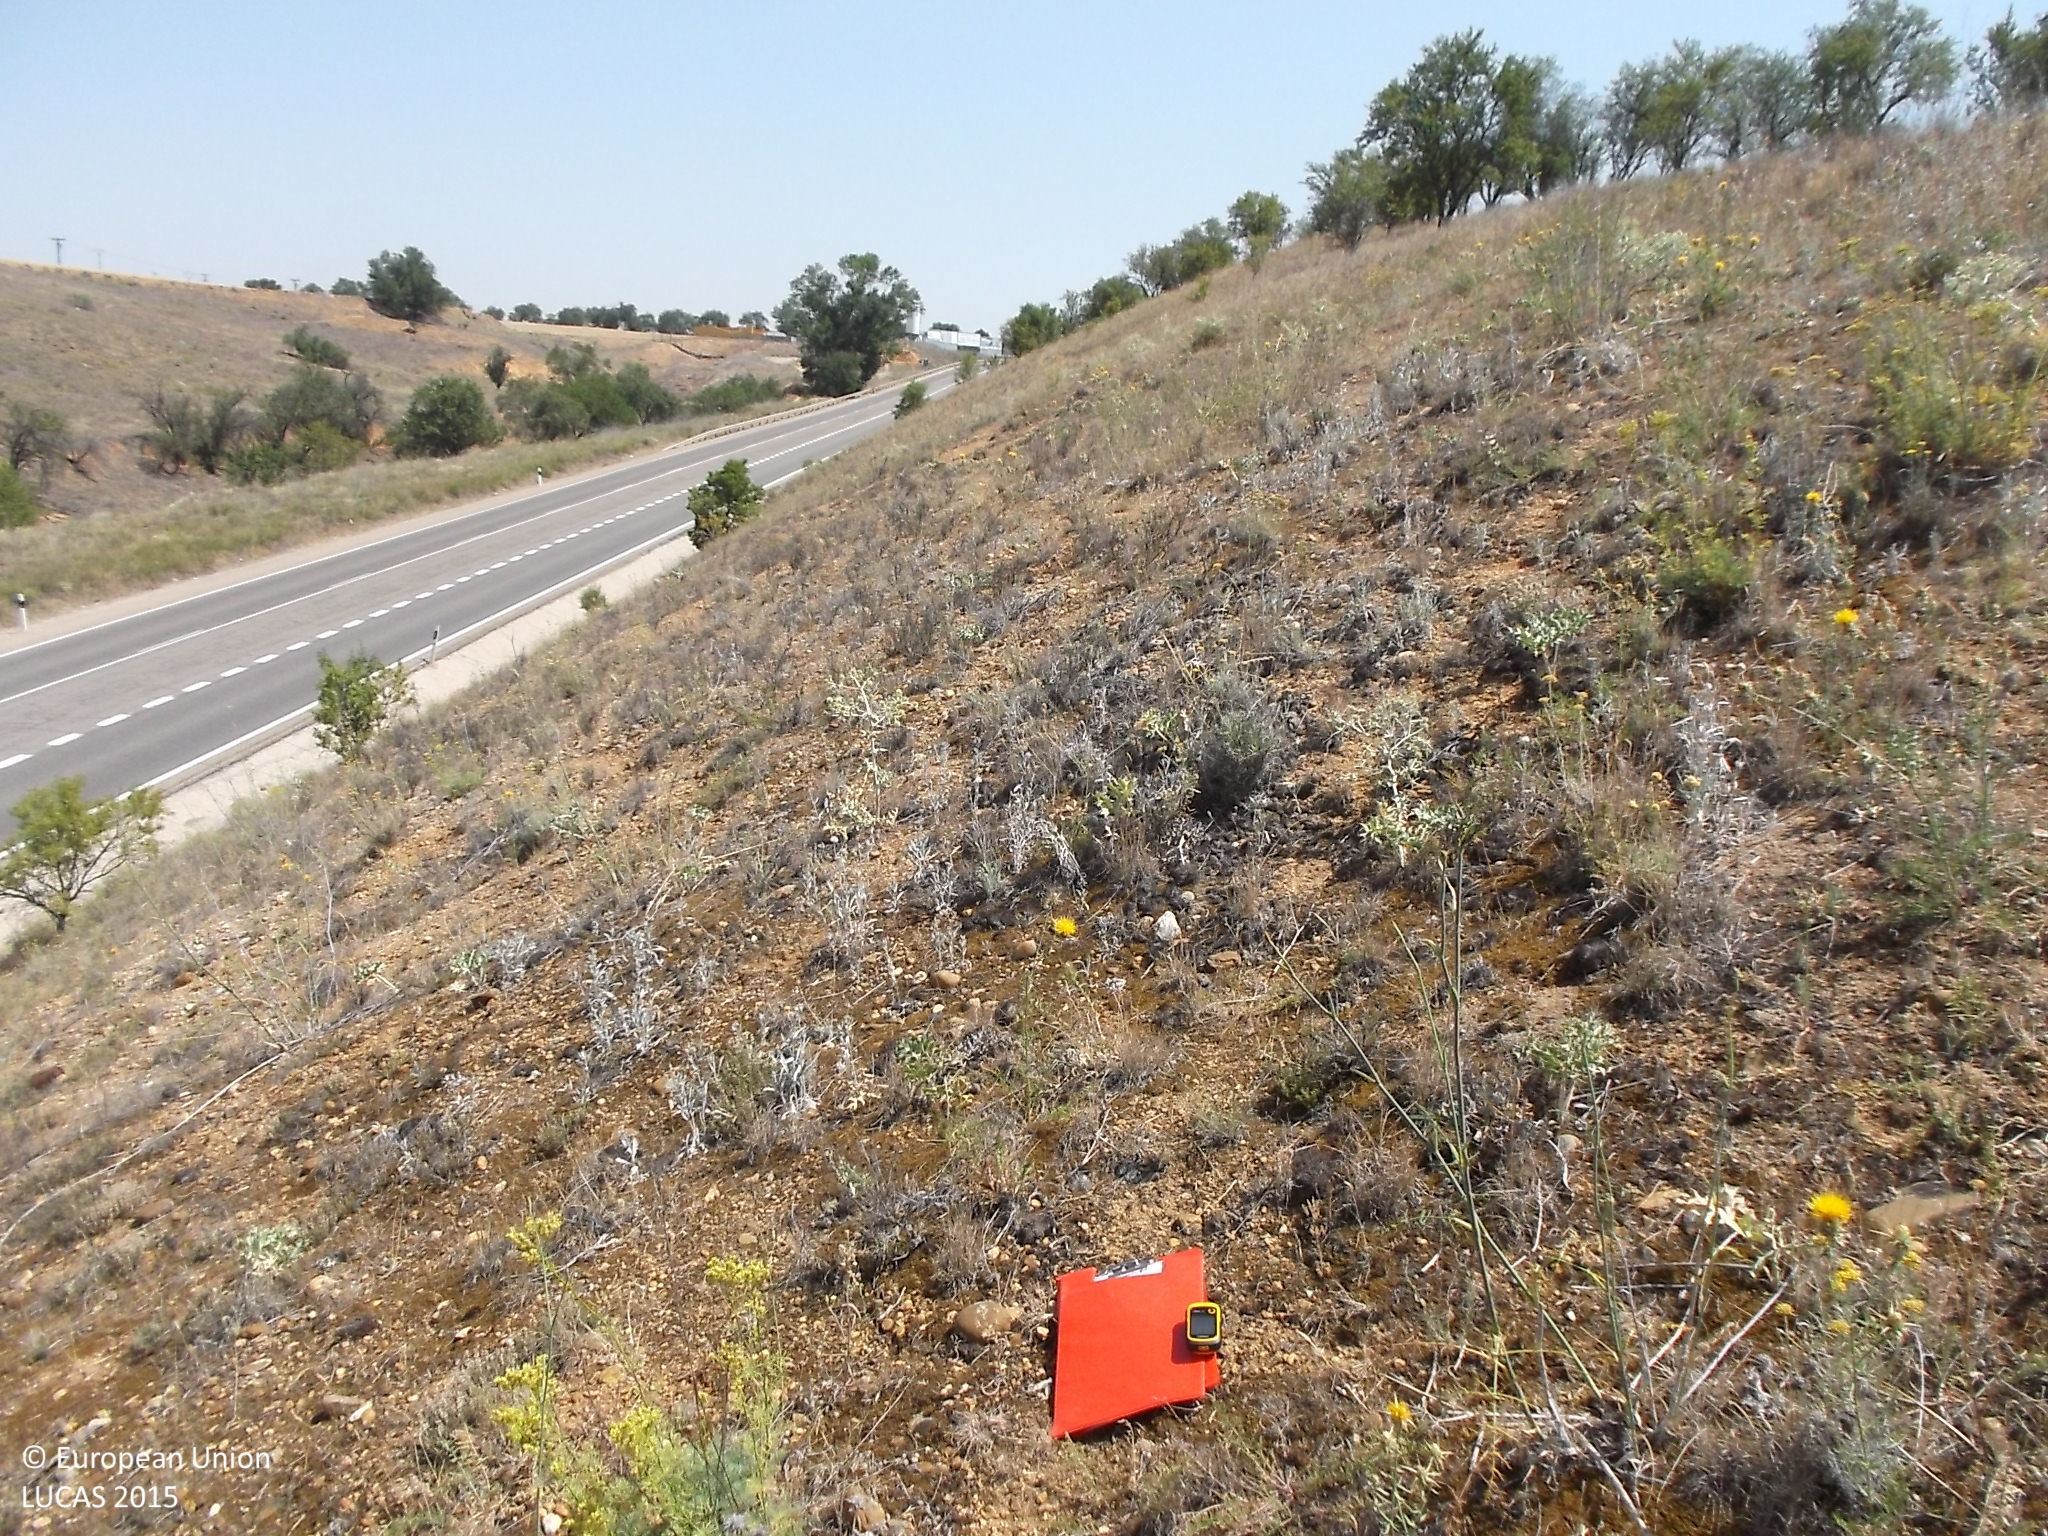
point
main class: Grassland
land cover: Grassland without tree/shrub cover
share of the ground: > 75 %
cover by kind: herbaceous plants 100 %
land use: Semi-natural and natural areas not in use
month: July
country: ES
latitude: 41.5221
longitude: -5.4069
